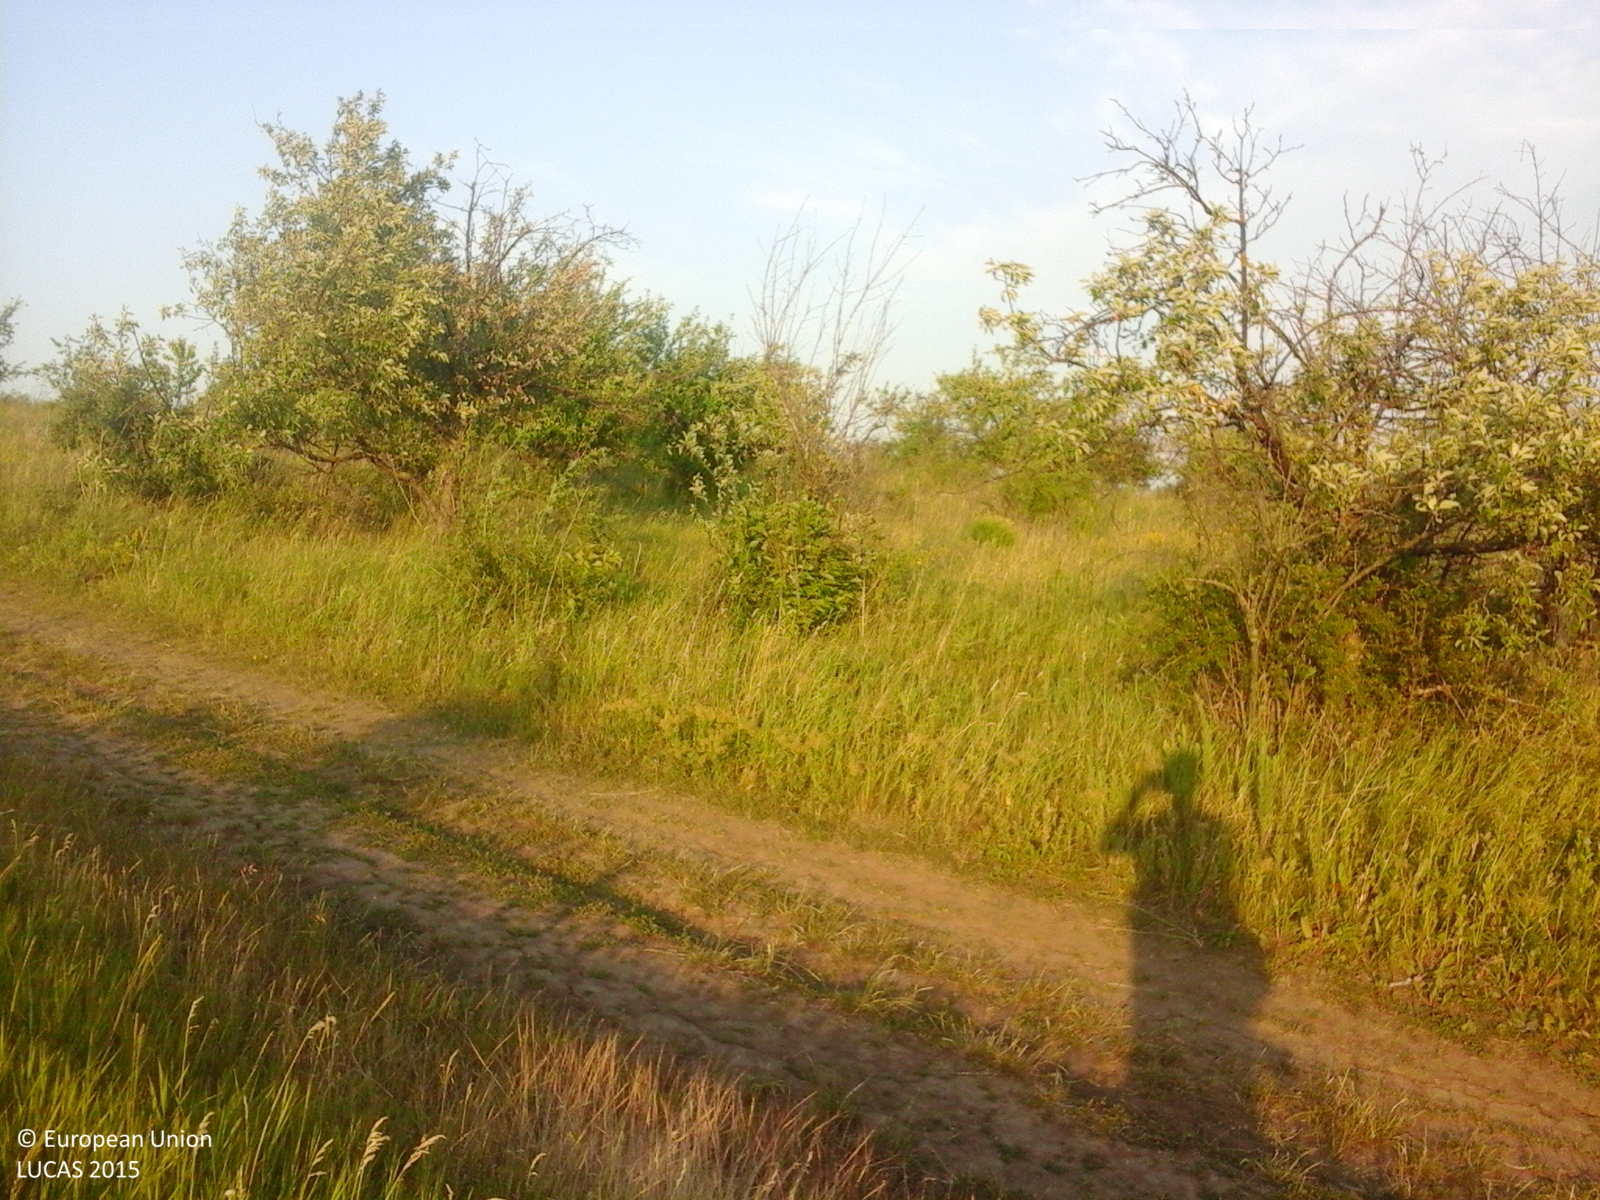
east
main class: Grassland
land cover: Grassland with sparse tree/shrub cover
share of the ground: > 75 %
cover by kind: herbaceous plants 85 %, shrubs 10 %, broadleaved forest trees 5 %
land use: Agriculture (excluding fallow land and kitchen gardens)
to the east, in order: Grassland with sparse tree/shrub cover; Tracks; Grassland with sparse tree/shrub cover; Shrubland with sparse tree cover; Maize; Tracks; Other fruit trees and berries; Other bare soil; Lucerne; Maize
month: June
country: RO
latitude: 46.8636
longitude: 27.2781
